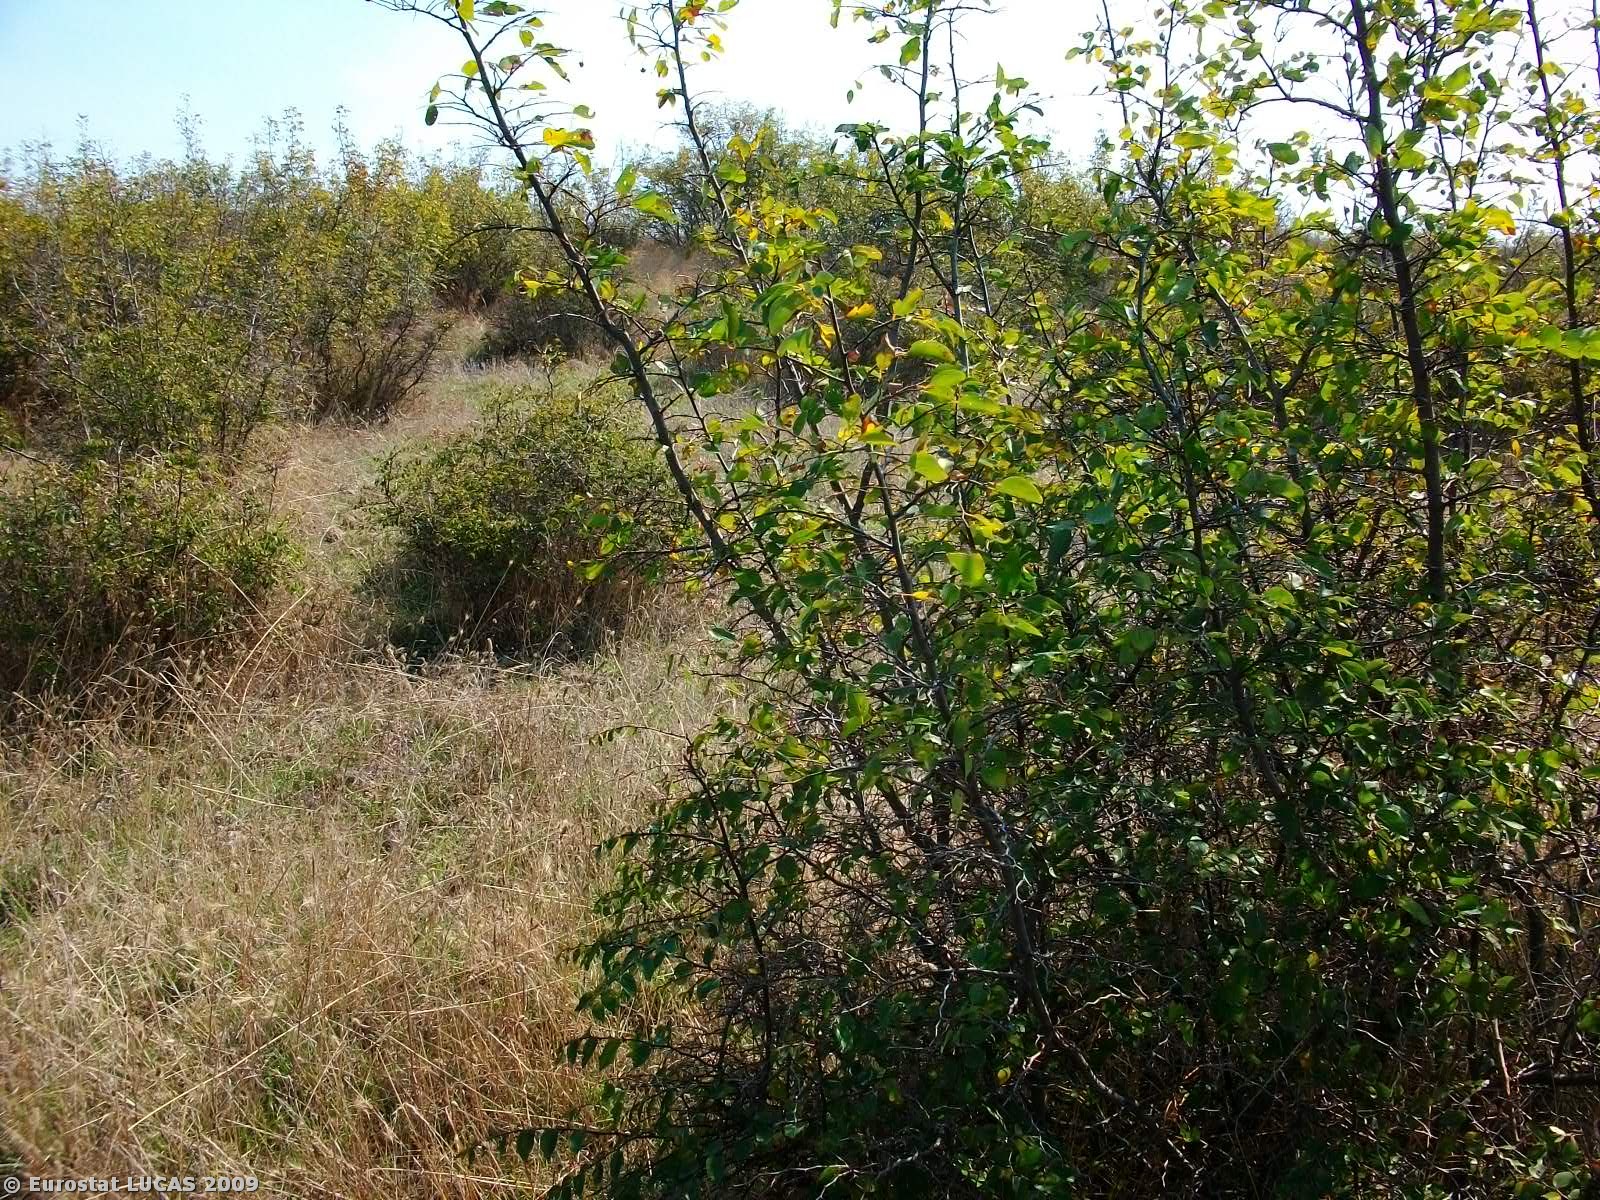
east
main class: Shrubland
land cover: Shrubland without tree cover
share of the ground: 50 - 75 %
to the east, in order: Shrubland without tree cover; Tracks; Shrubland without tree cover; Tracks; Grassland with sparse tree/shrub cover
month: September
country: GR
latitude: 40.9581
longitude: 26.2837
